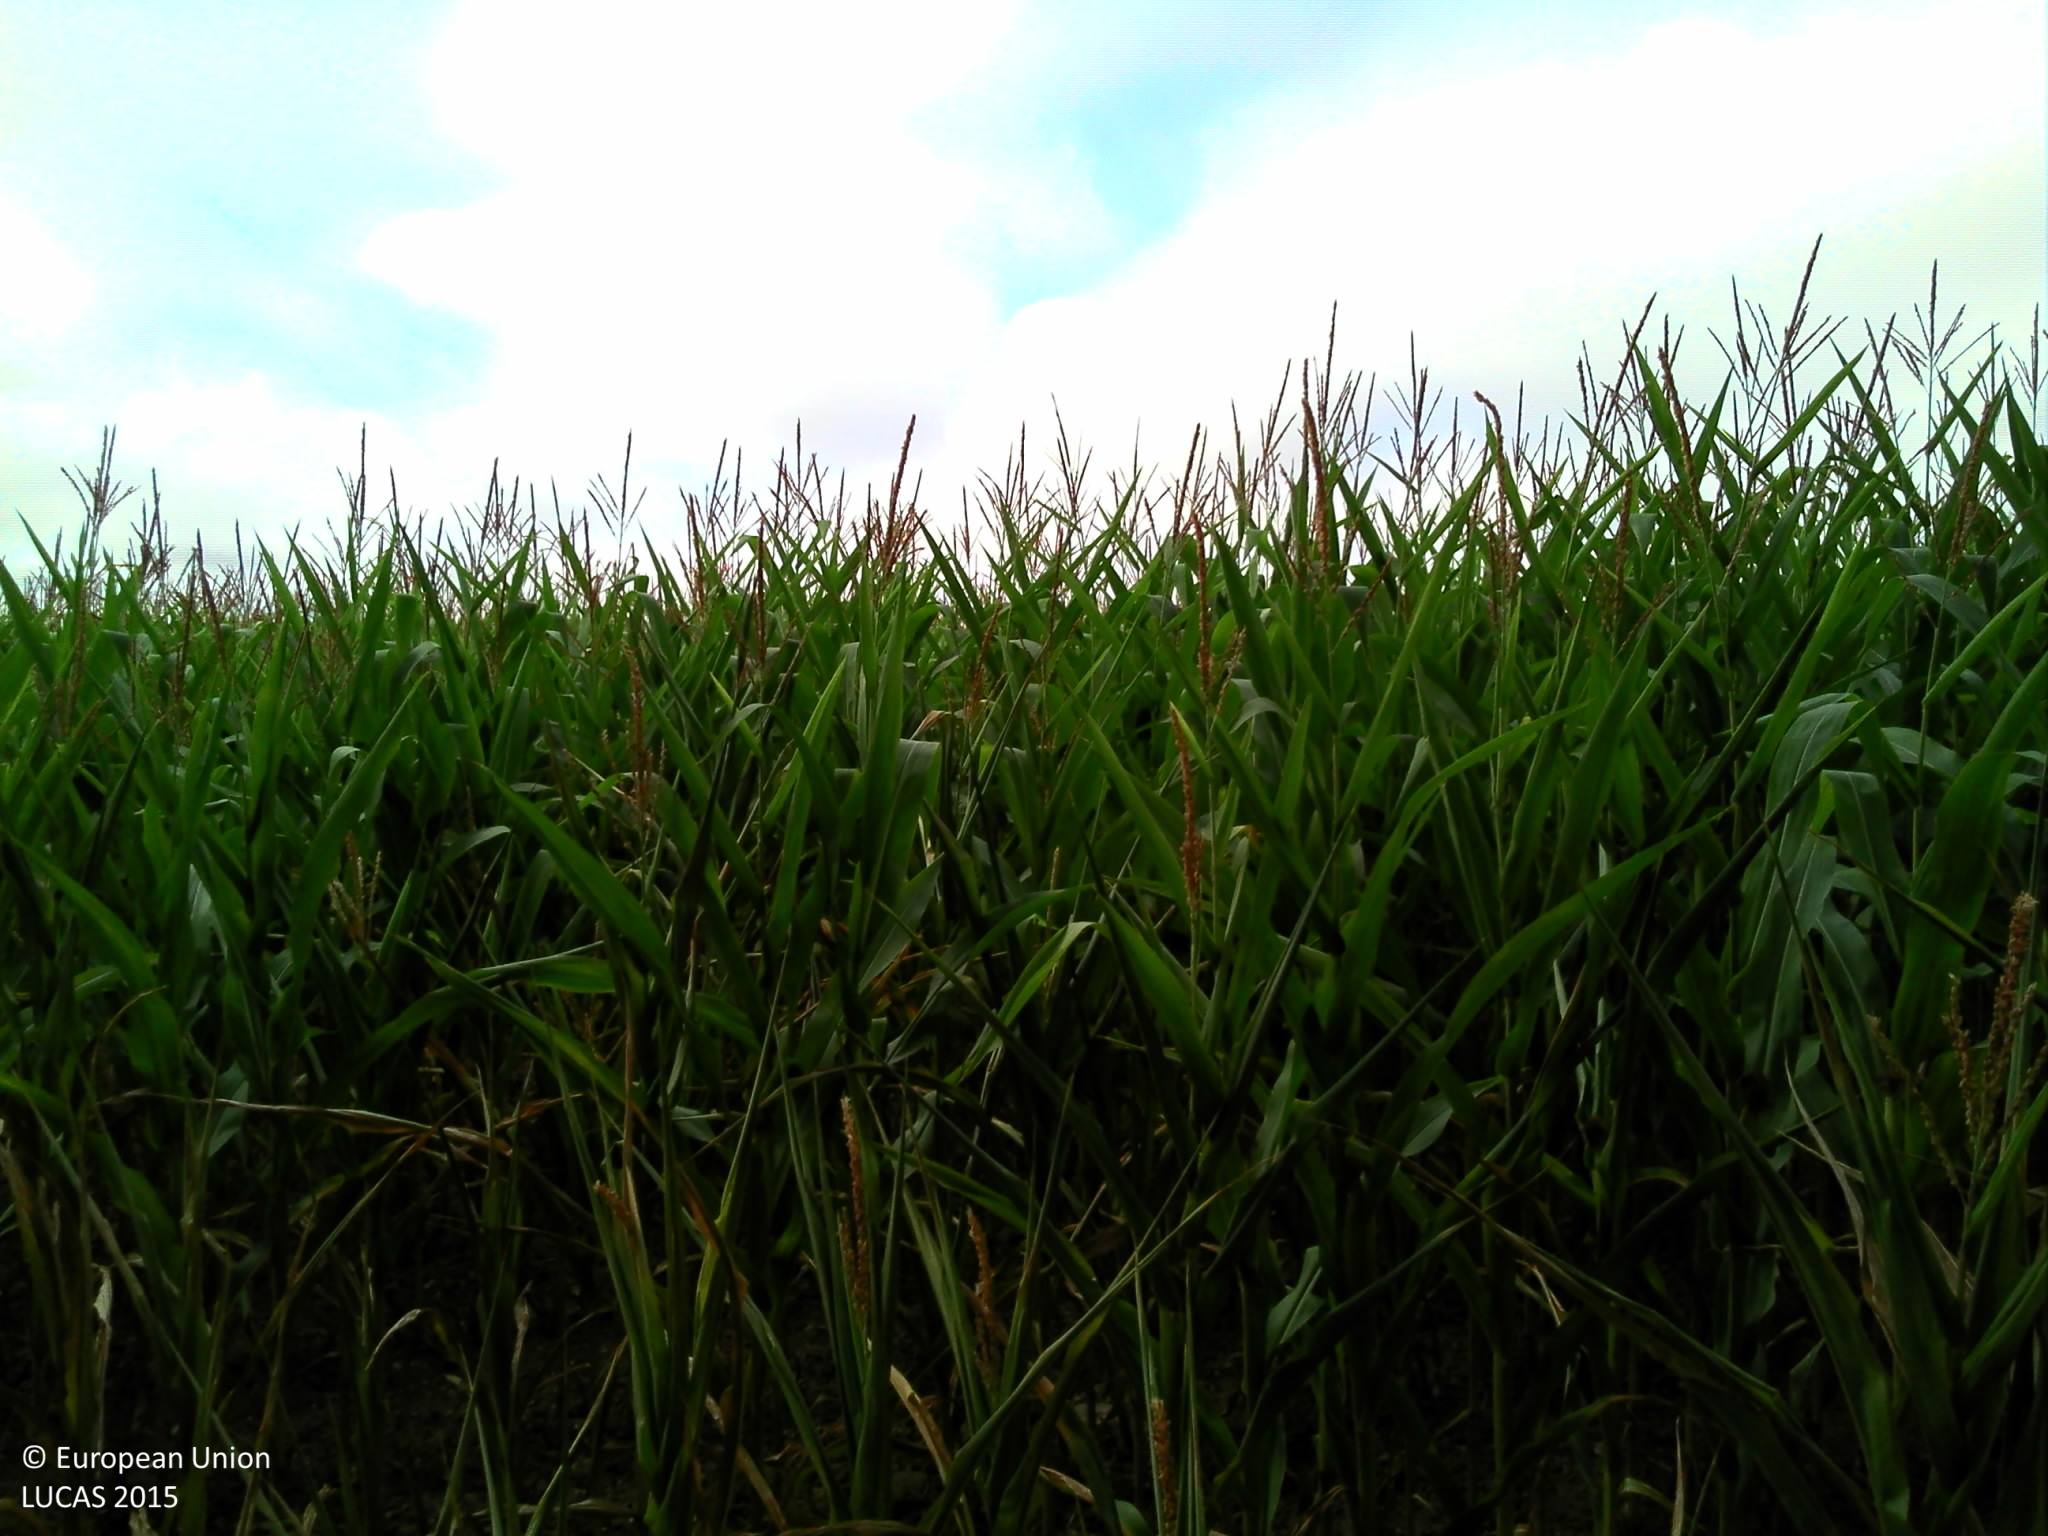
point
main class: Cropland
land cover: Maize
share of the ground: > 75 %
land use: Agriculture (excluding fallow land and kitchen gardens)
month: July
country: FR
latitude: 46.2718
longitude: 0.4980
